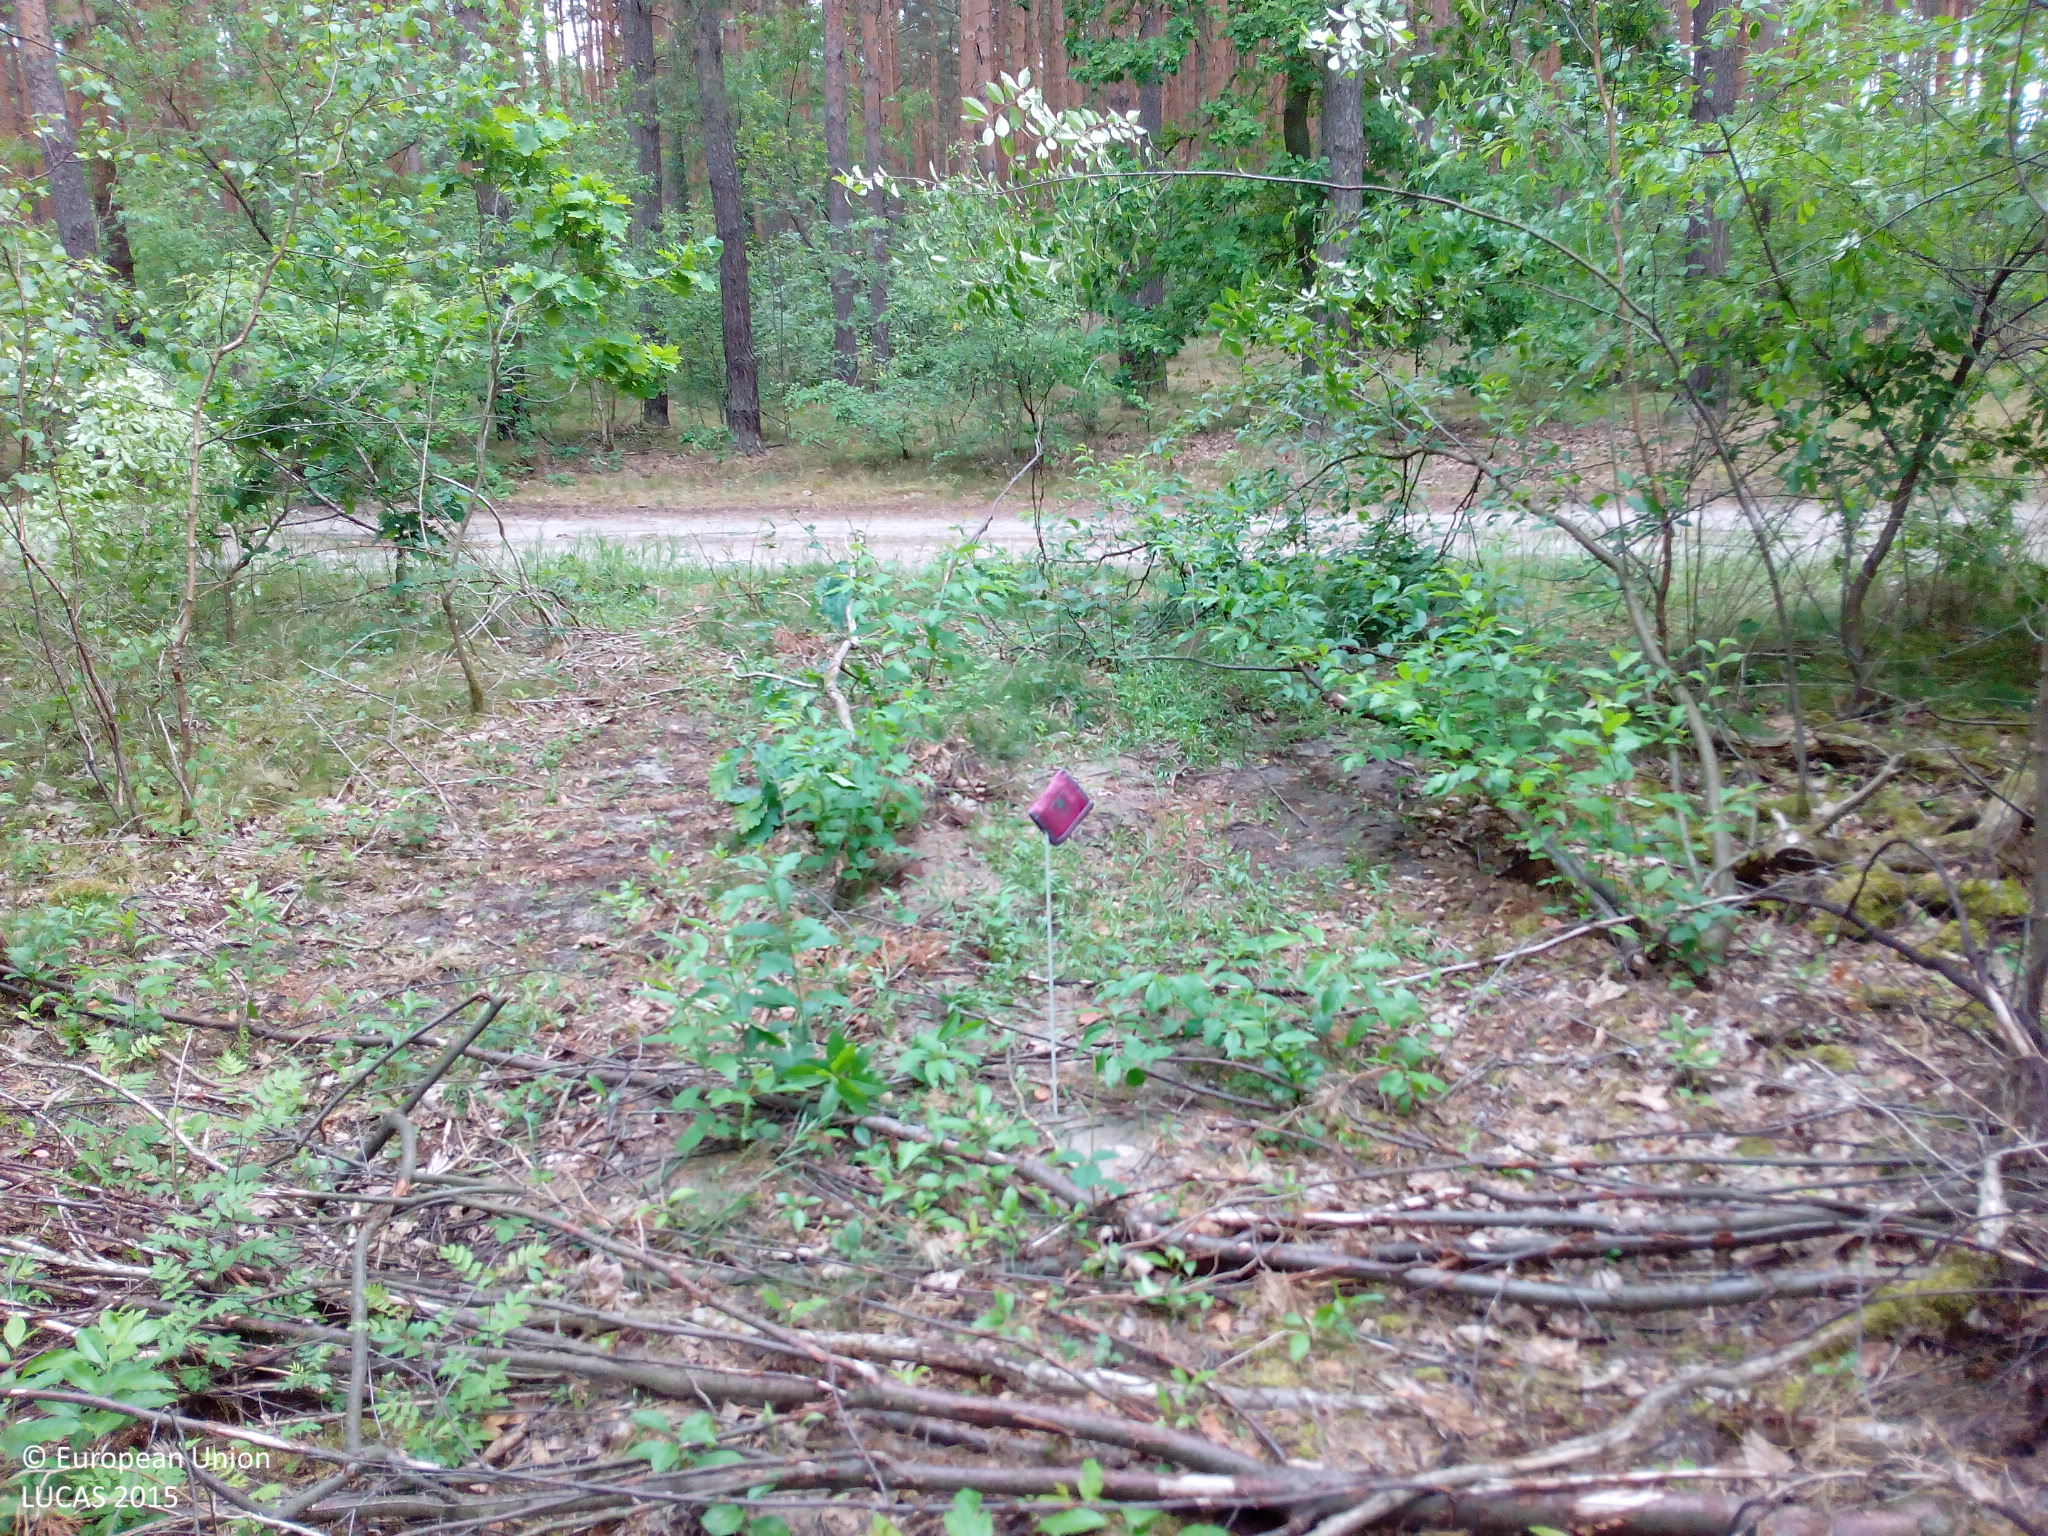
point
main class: Woodland
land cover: Pine dominated mixed woodland
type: hemiboreal forest and nemoral coniferous forest and mixed broadleaved-coniferous forest
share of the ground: 50 - 75 %
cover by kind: coniferous forest trees 50 %, broadleaved forest trees 20 %, shrubs 10 %, lichens and mosses 10 %, herbaceous plants 5 %, unconsolidated bare surface 5 %
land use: Forestry
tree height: > 5 m
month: June
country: DE
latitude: 52.5151
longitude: 12.4015
